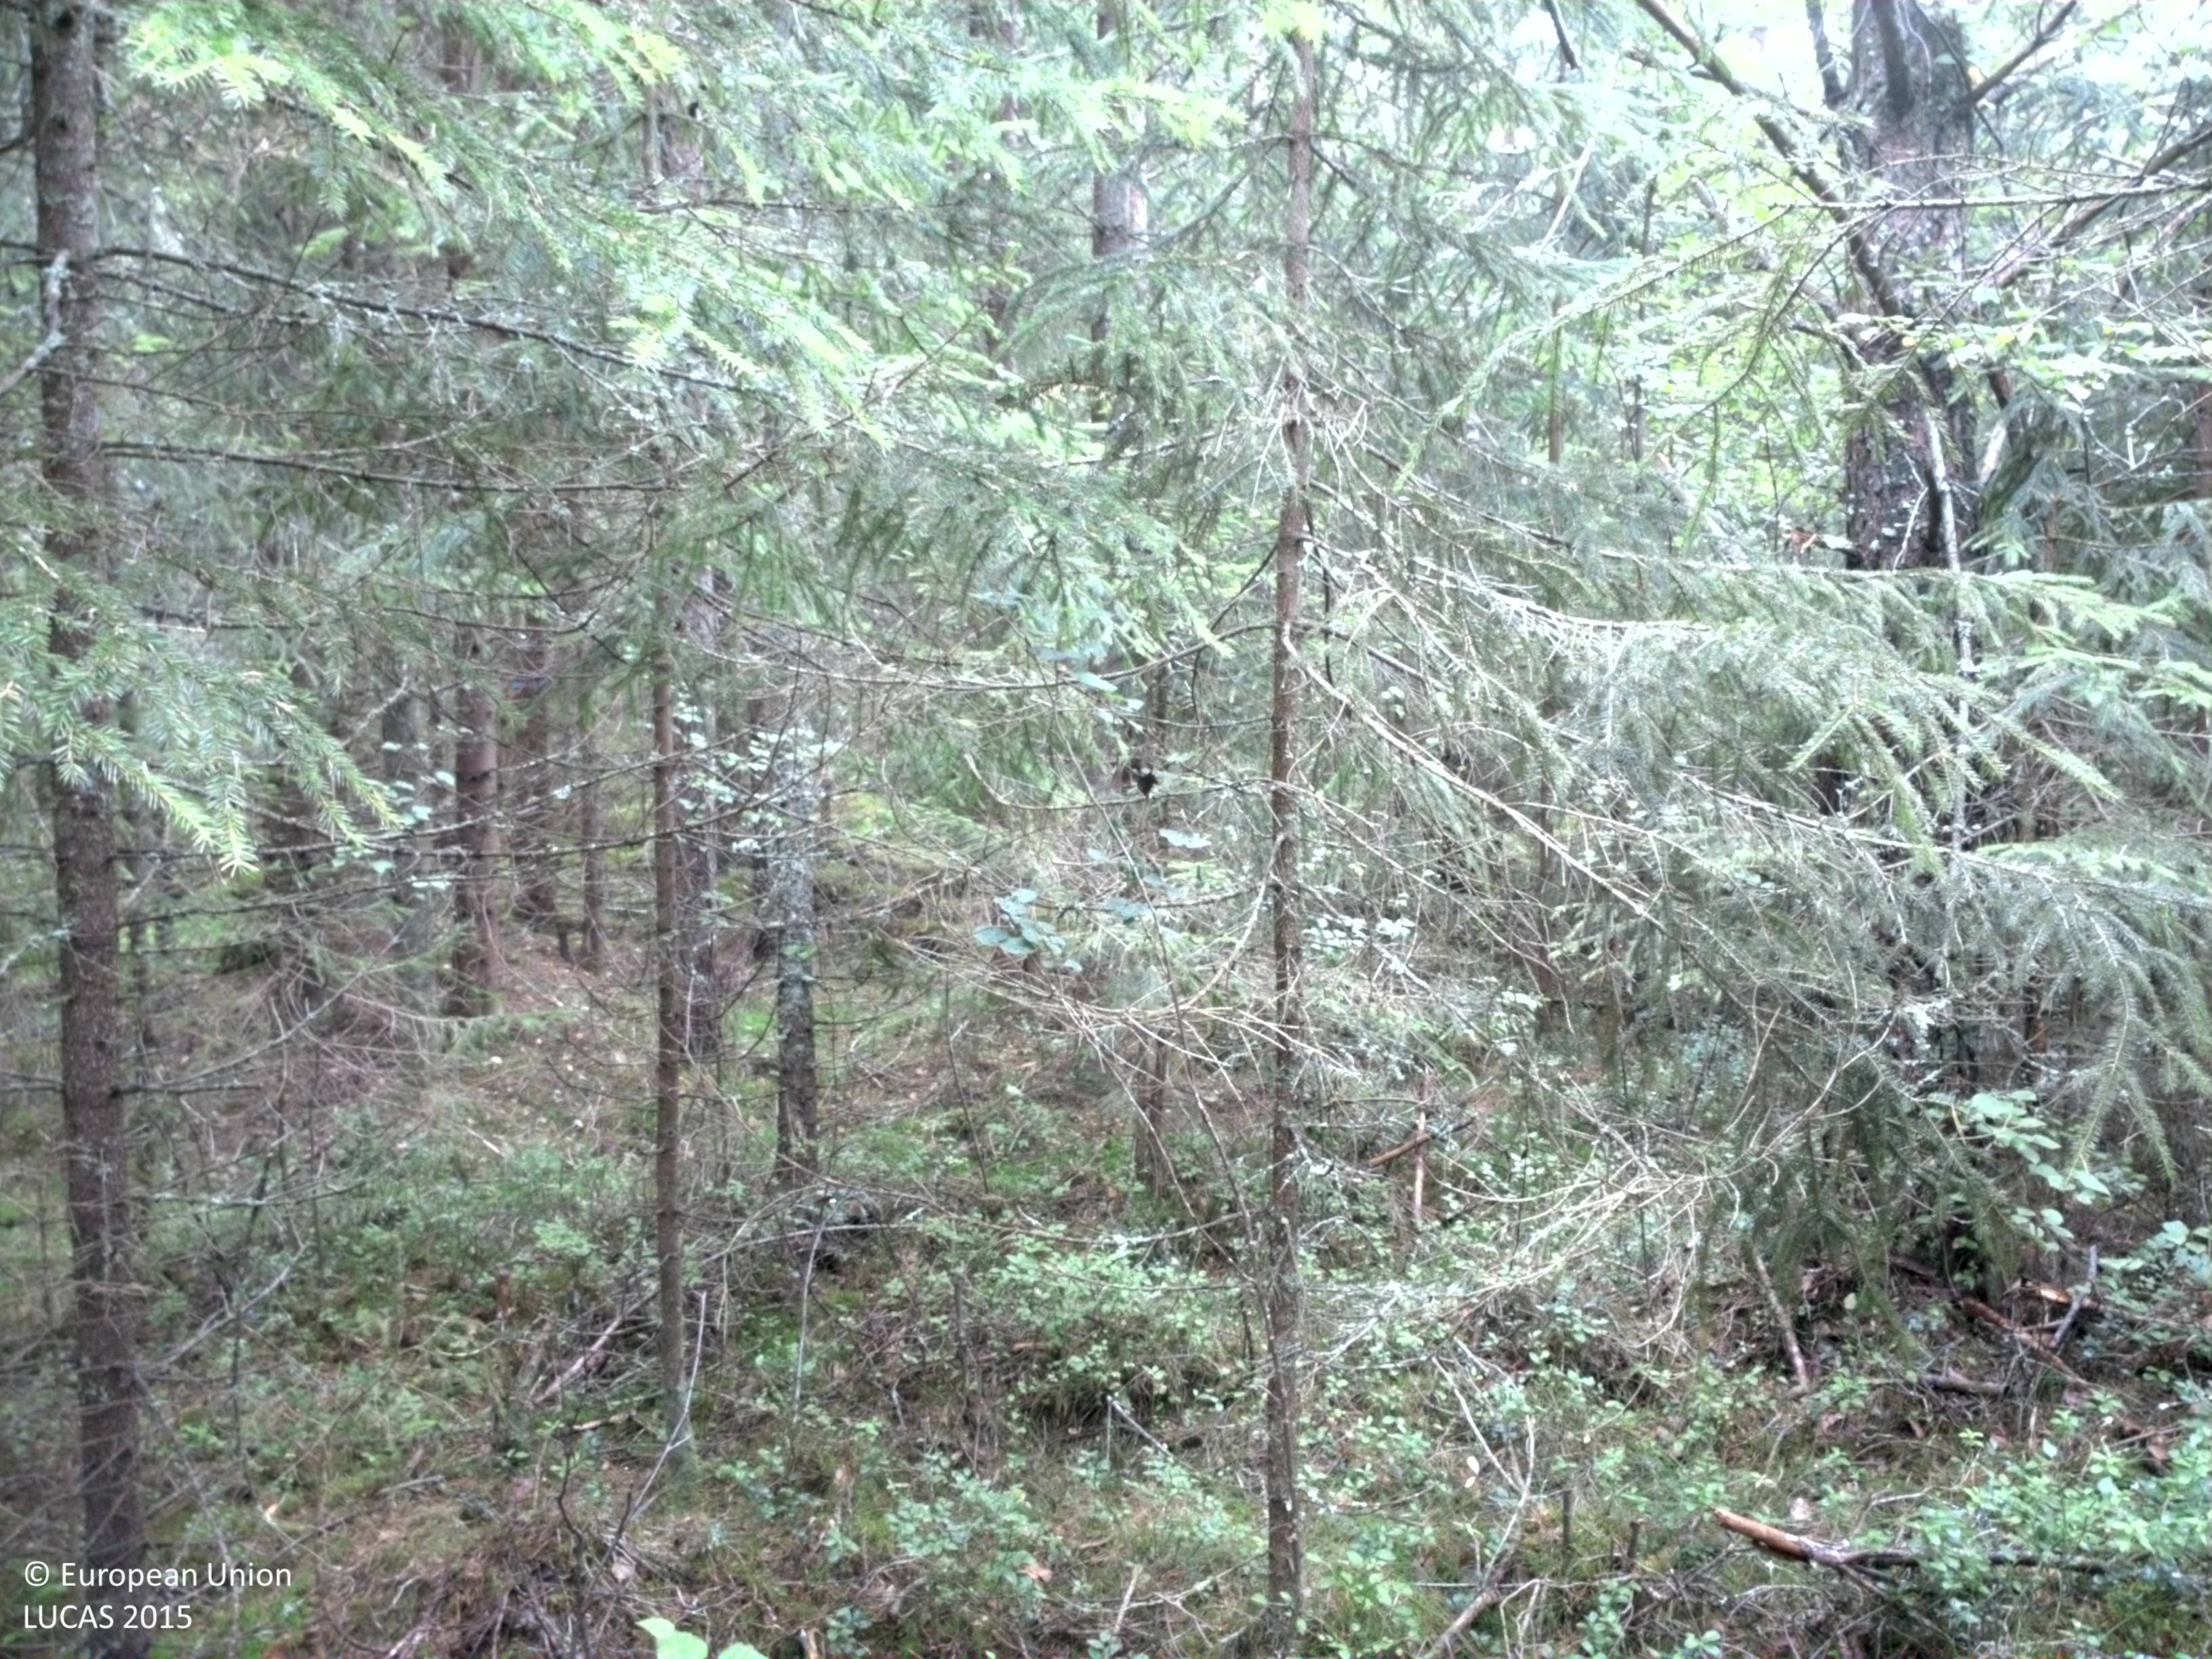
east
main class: Woodland
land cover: Other coniferous woodland
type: boreal forest
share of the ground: 50 - 75 %
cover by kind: coniferous forest trees 65 %, lichens and mosses 25 %, broadleaved forest trees 5 %, shrubs 5 %
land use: Forestry
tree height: > 5 m
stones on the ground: < 10 %
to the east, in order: Other coniferous woodland; Spruce dominated mixed woodland; Rivers and streams; Spruce dominated mixed woodland; Pine dominated coniferous woodland; Tracks; Pine dominated coniferous woodland; Spruce dominated coniferous woodland; Rivers and streams; Spruce dominated coniferous woodland; Pine dominated coniferous woodland
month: August
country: SE
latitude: 59.6203
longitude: 13.2716
